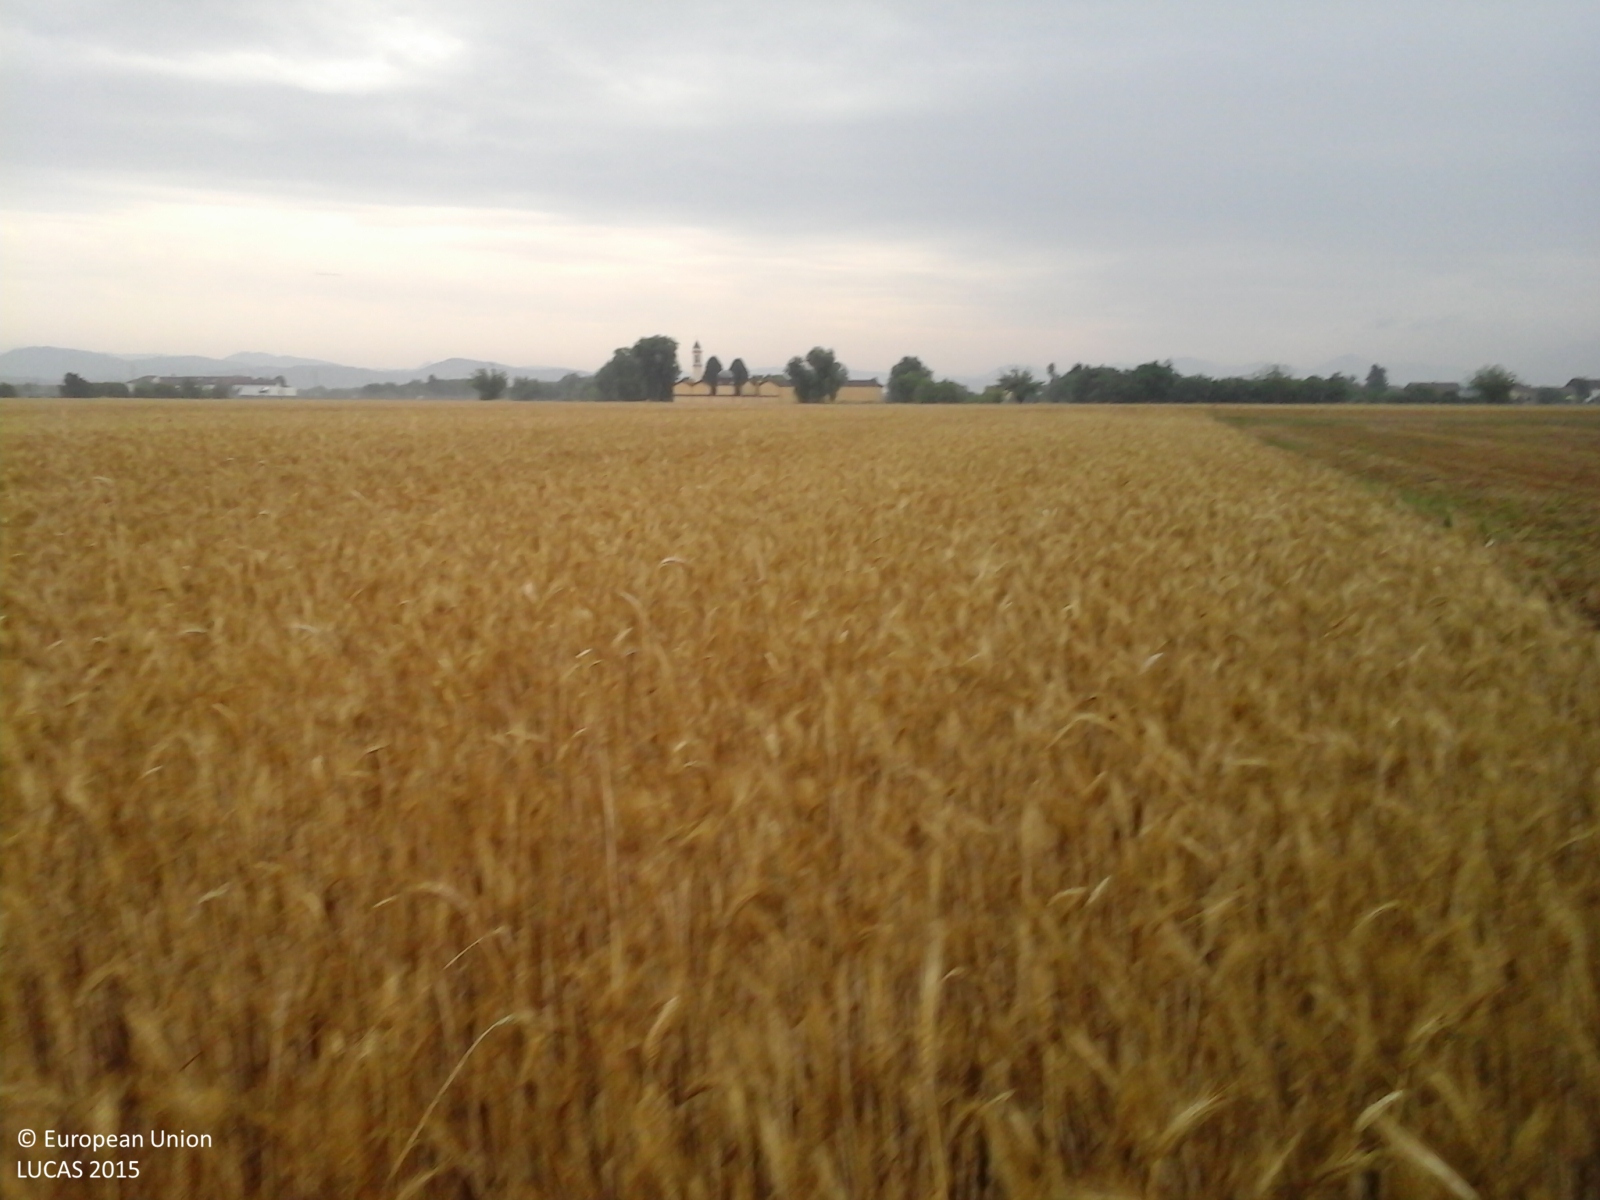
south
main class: Cropland
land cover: Common wheat
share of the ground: > 75 %
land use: Agriculture (excluding fallow land and kitchen gardens)
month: June
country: IT
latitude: 44.8128
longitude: 8.8264
